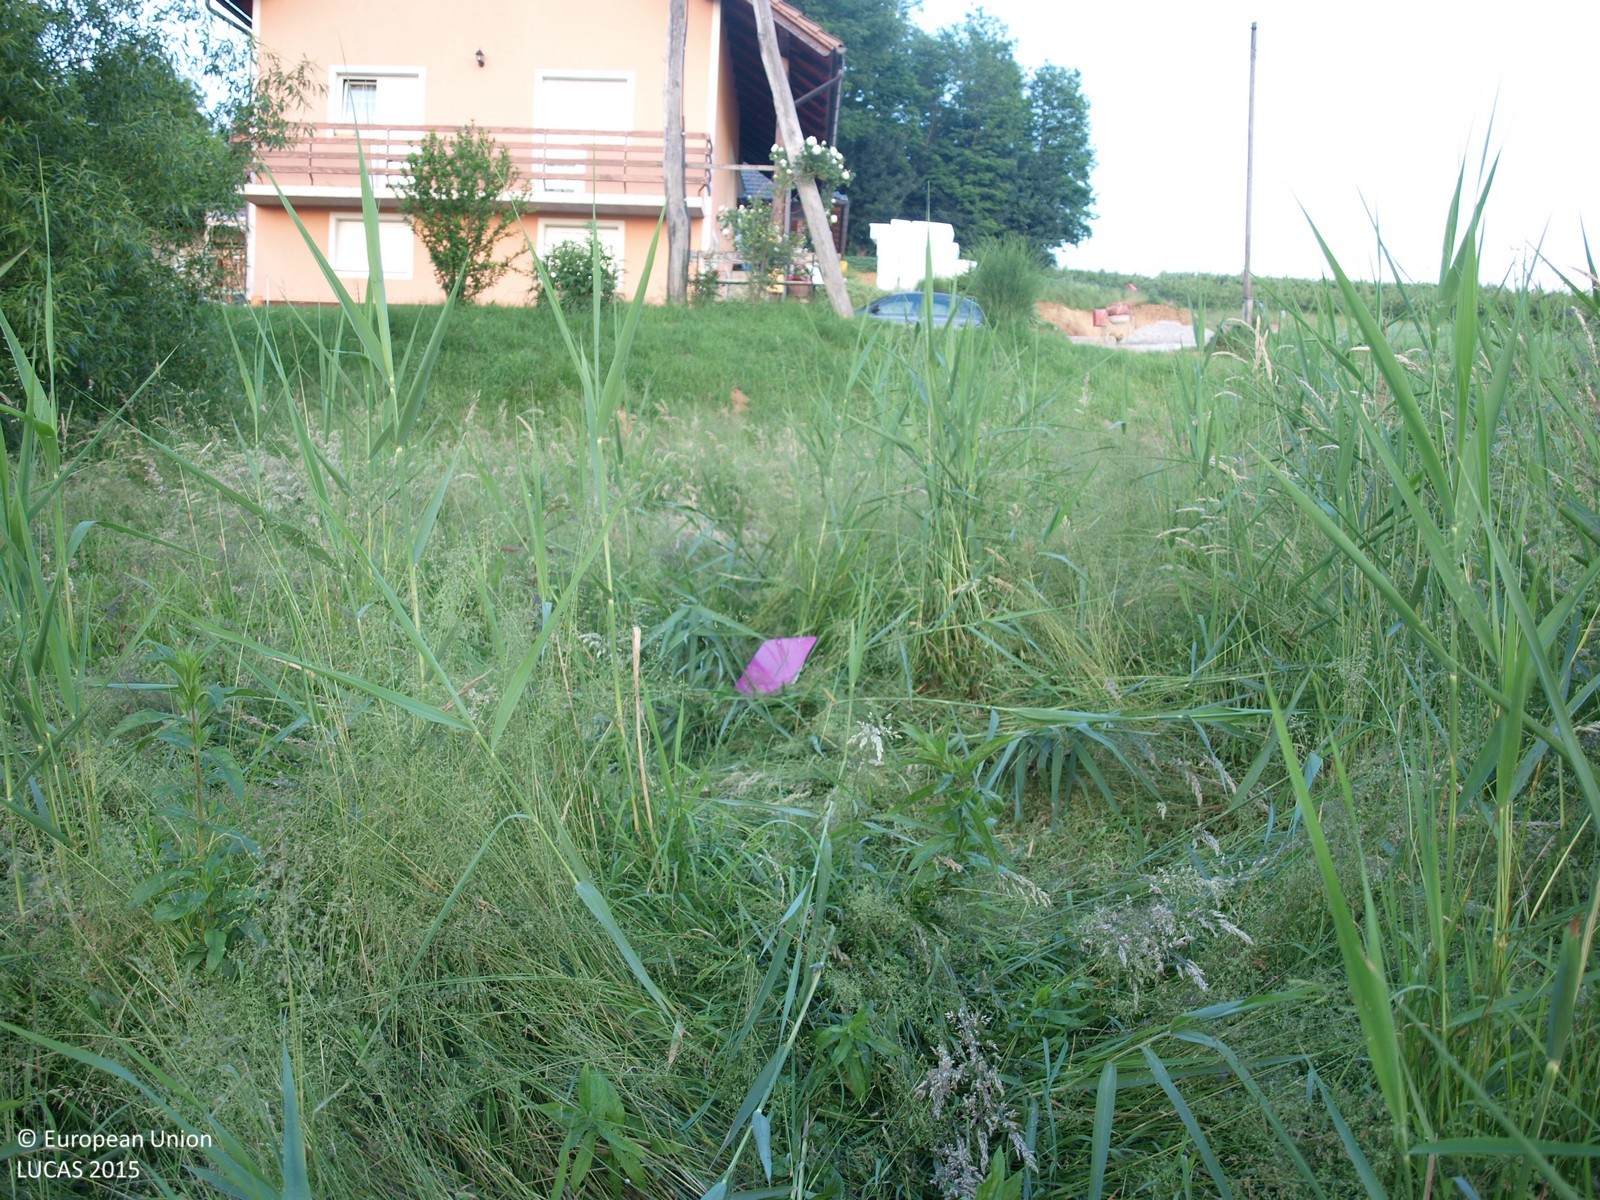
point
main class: Grassland
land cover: Grassland without tree/shrub cover
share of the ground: > 75 %
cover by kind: herbaceous plants 100 %
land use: Residential
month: June
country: HR
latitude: 46.3027
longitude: 16.1147
